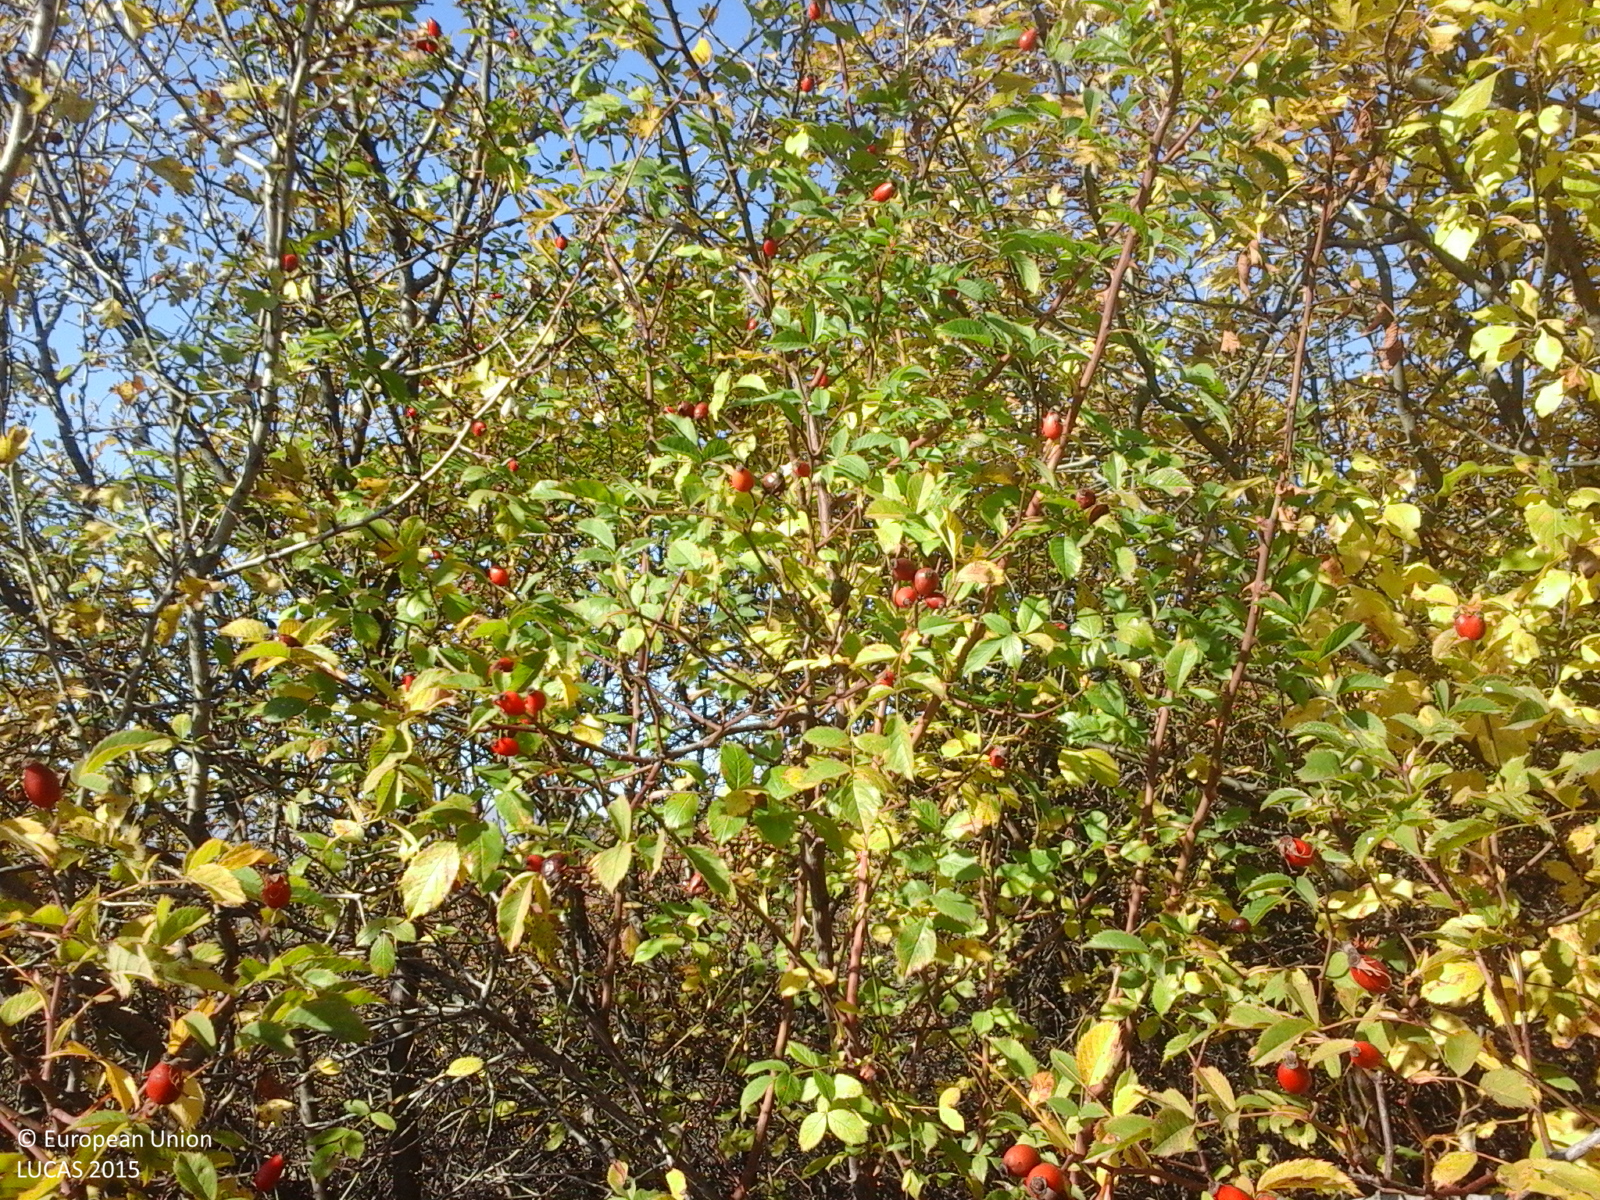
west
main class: Shrubland
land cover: Shrubland without tree cover
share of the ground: > 75 %
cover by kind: shrubs 100 %
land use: Fallow land
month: October
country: RO
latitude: 45.3268
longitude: 26.5454
